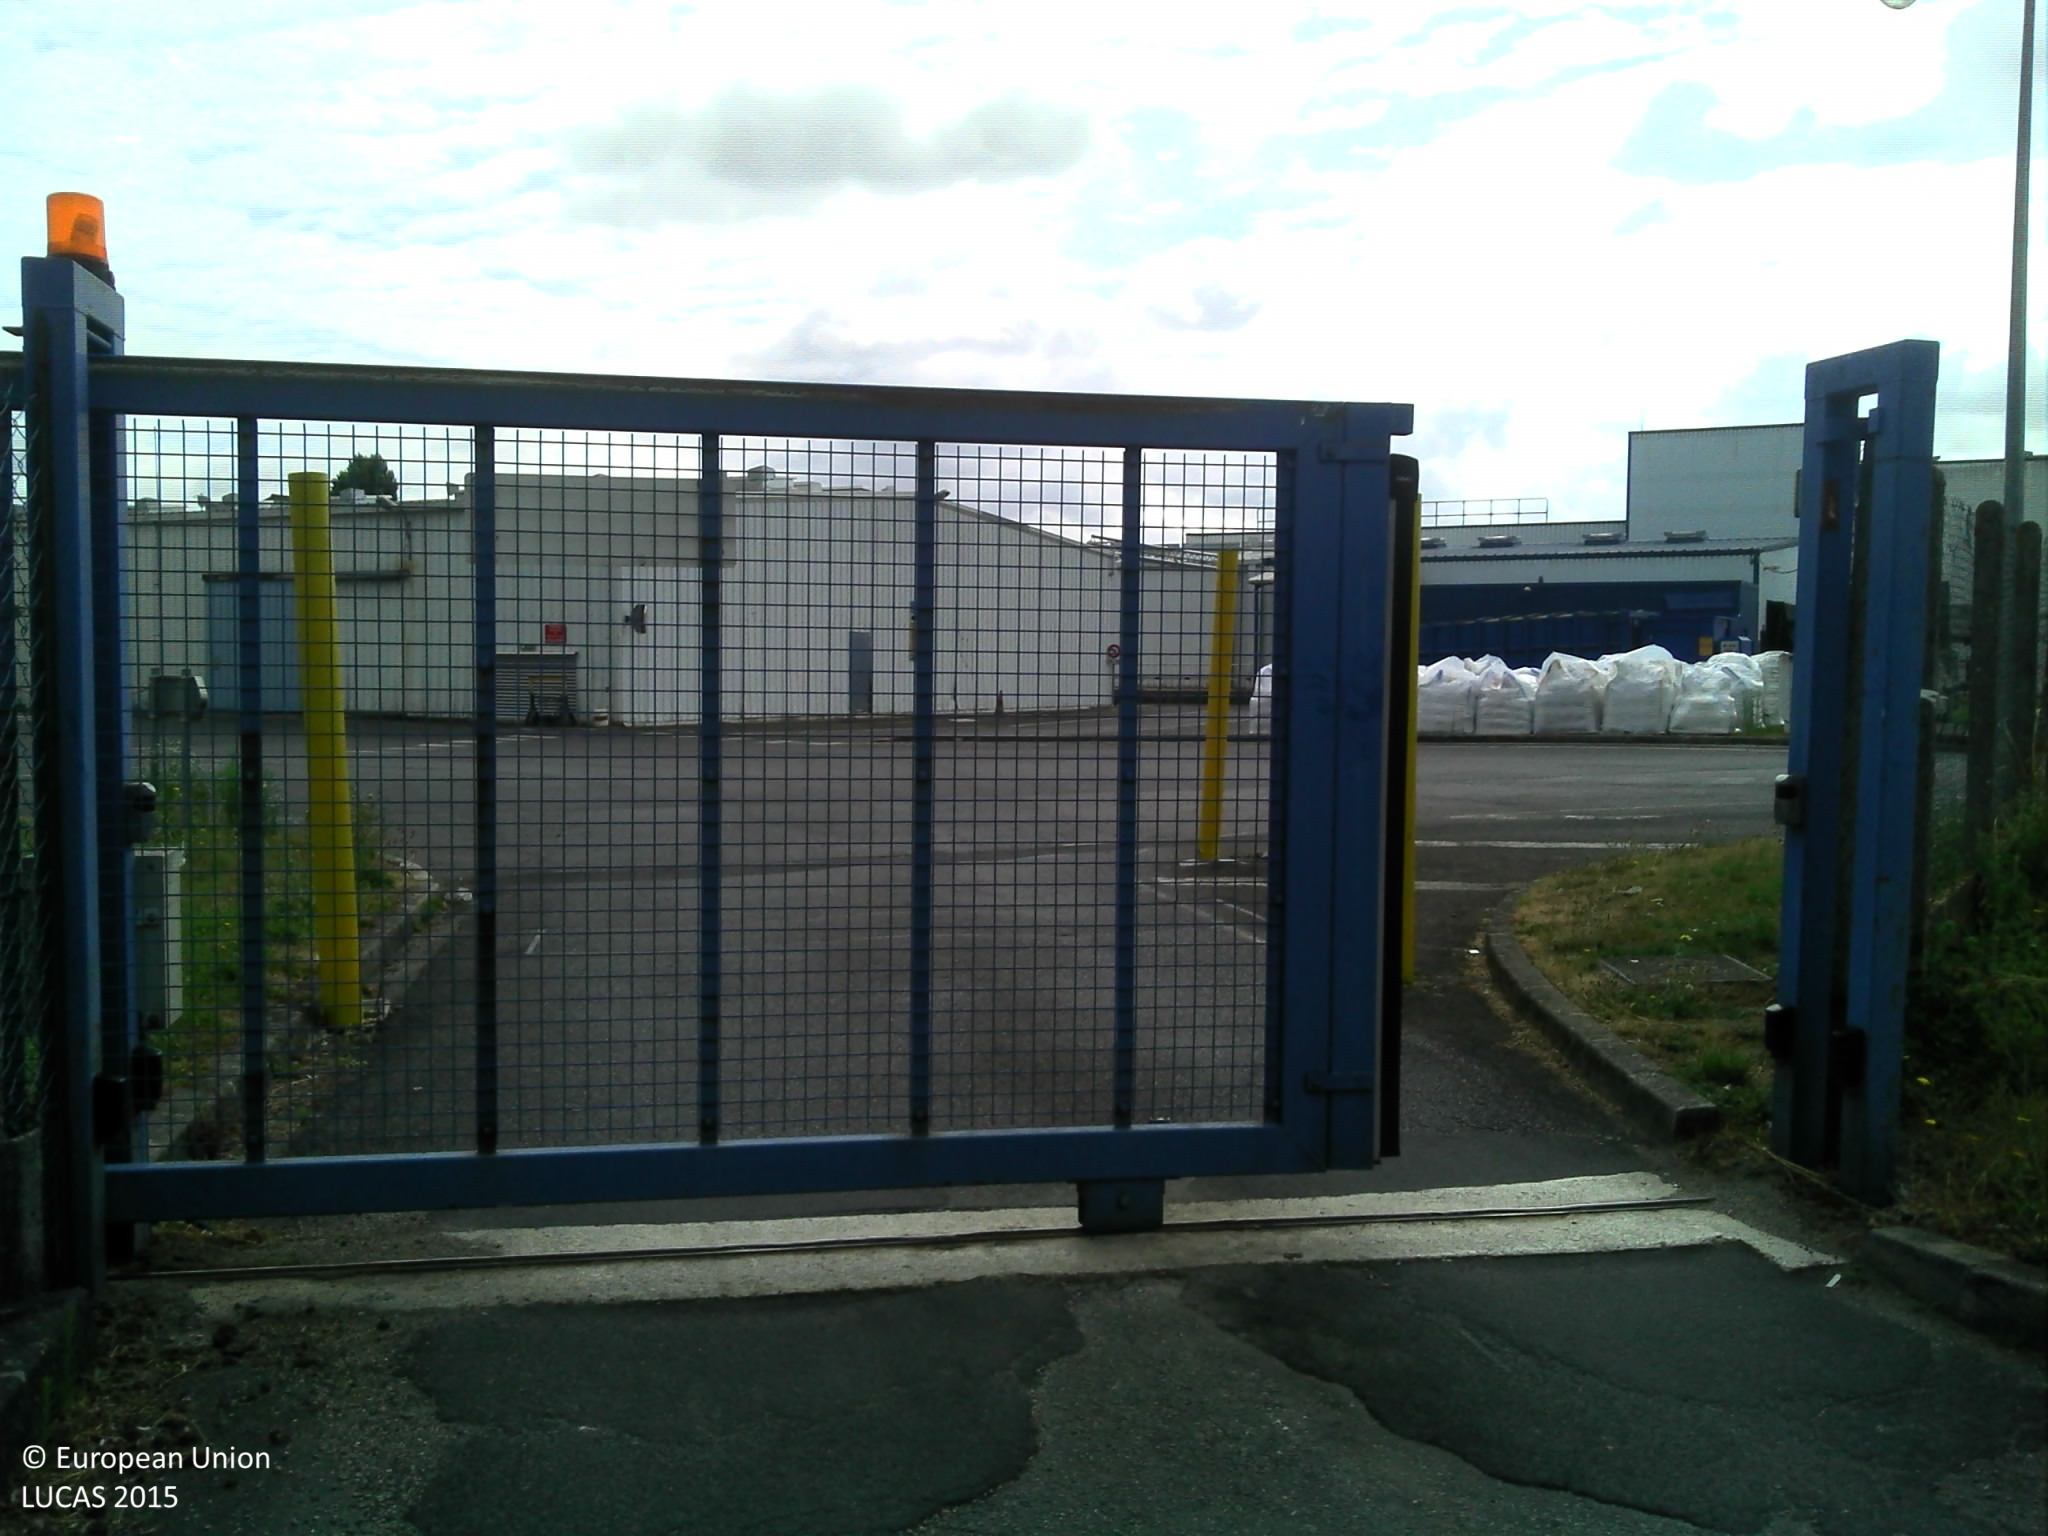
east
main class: Grassland
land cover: Grassland without tree/shrub cover
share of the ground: > 75 %
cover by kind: herbaceous plants 90 %, consolidated bare surface 10 %
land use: Logistics and storage
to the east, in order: Grassland without tree/shrub cover; Artificial constructions in urban areas; Inland fresh water bodies; Grassland without tree/shrub cover; Artificial constructions in urban areas
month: July
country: FR
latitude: 48.6678
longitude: 2.6984
